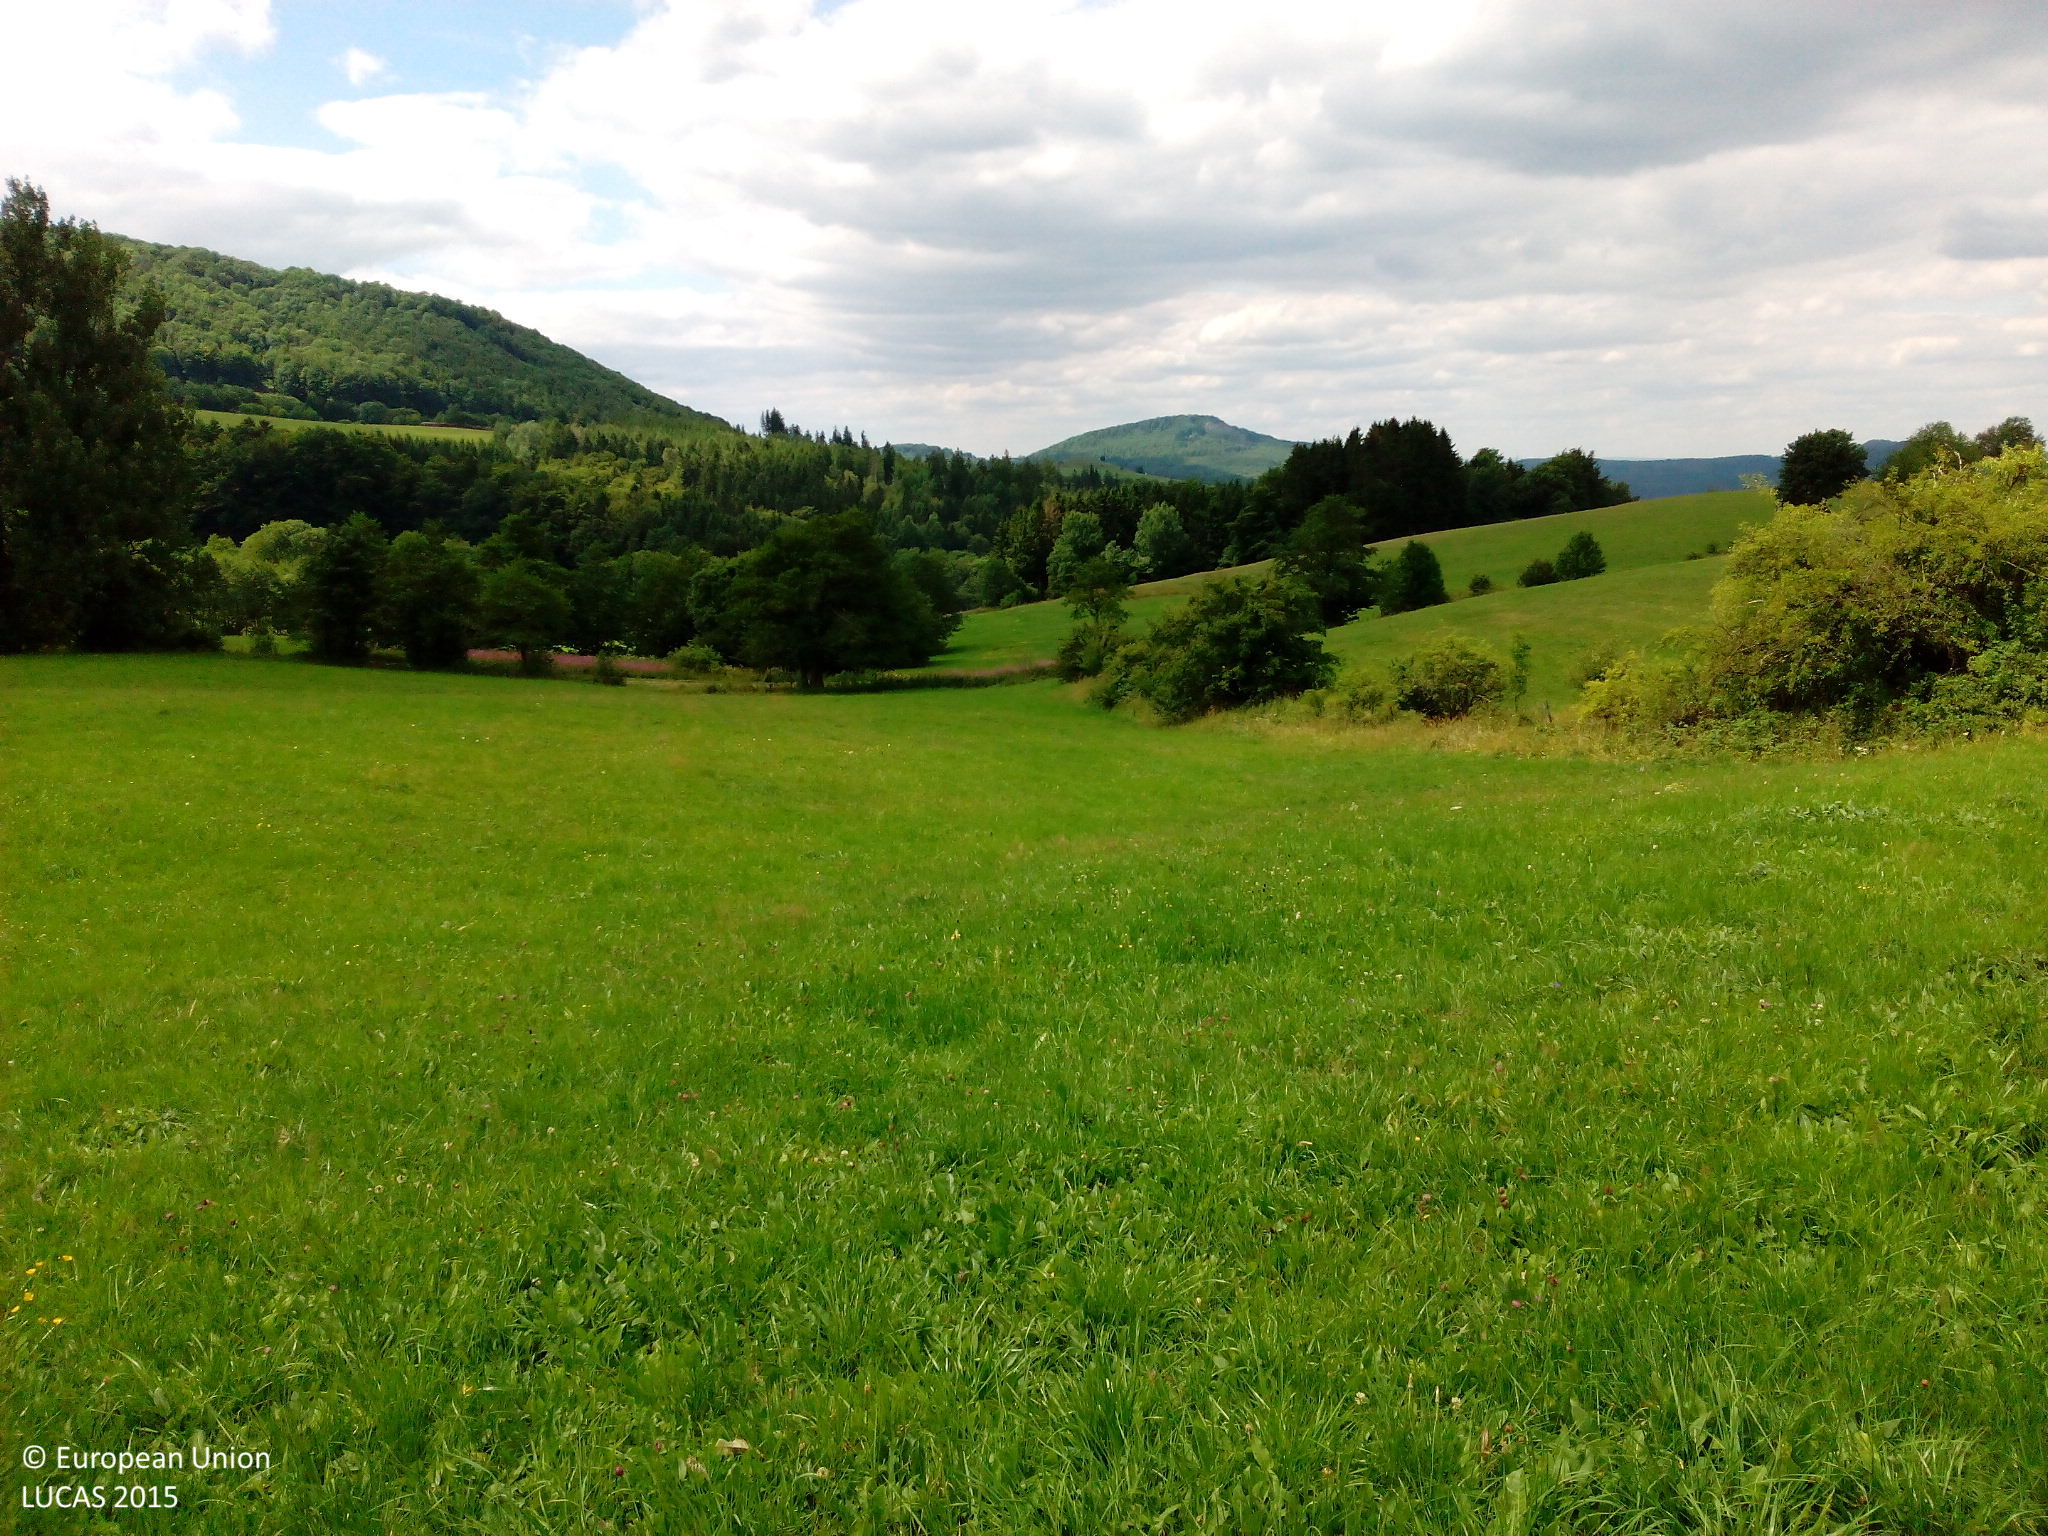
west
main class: Grassland
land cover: Grassland without tree/shrub cover
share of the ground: > 75 %
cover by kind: herbaceous plants 100 %
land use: Agriculture (excluding fallow land and kitchen gardens)
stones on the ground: < 10 %
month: July
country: DE
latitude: 50.4360
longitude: 9.9578
